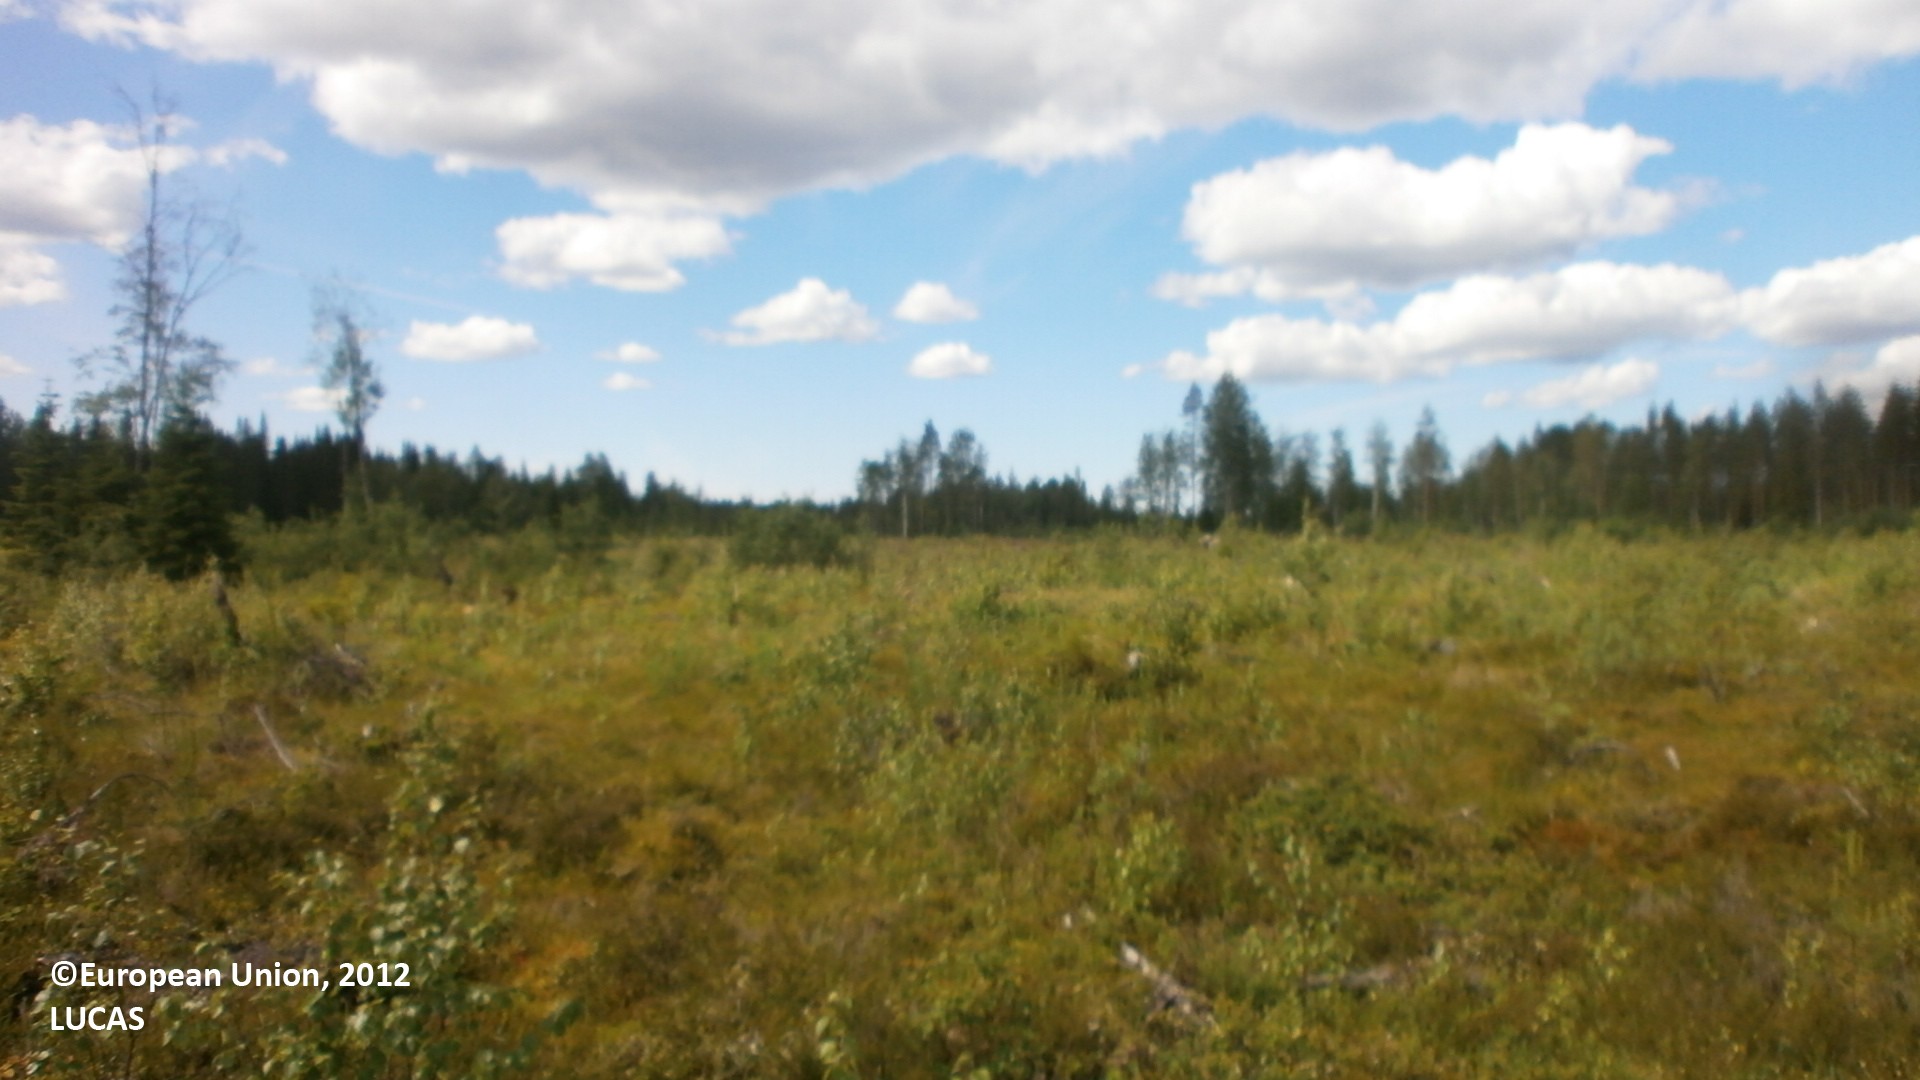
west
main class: Woodland
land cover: Other mixed woodland
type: boreal forest
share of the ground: 10 - 25 %
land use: Forestry
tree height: < 5 m
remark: Clear cut
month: July
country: FI
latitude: 64.1250
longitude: 24.9726
